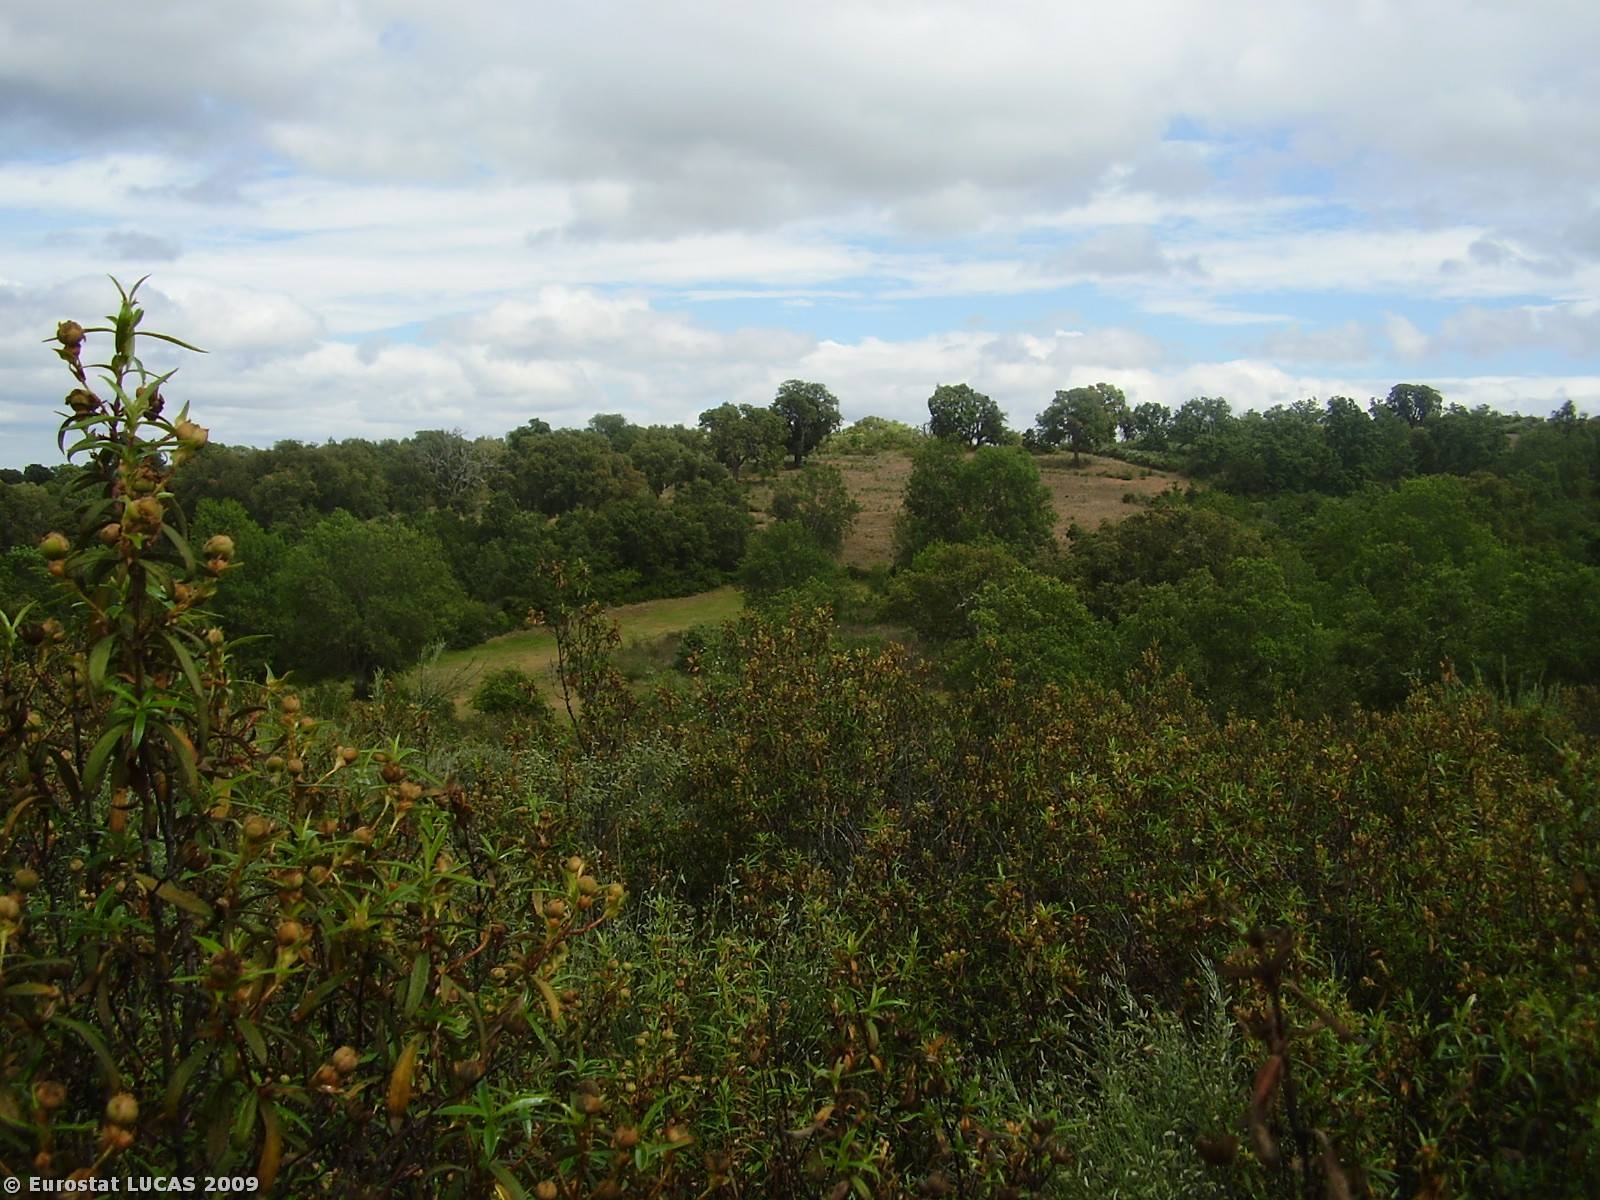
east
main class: Shrubland
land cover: Shrubland with sparse tree cover
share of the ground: > 75 %
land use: Nature reserves
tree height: > 5 m
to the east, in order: Shrubland with sparse tree cover; Broadleaved woodland; Dry stone walls; Temporary grasslands; Broadleaved woodland; Dry stone walls; Single bushes/trees; Shruby margins; Broadleaved woodland; Spontaneously vegetated surfaces; Single bushes/trees; Spontaneously vegetated surfaces
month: June
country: PT
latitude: 41.5460
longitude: -6.8344
